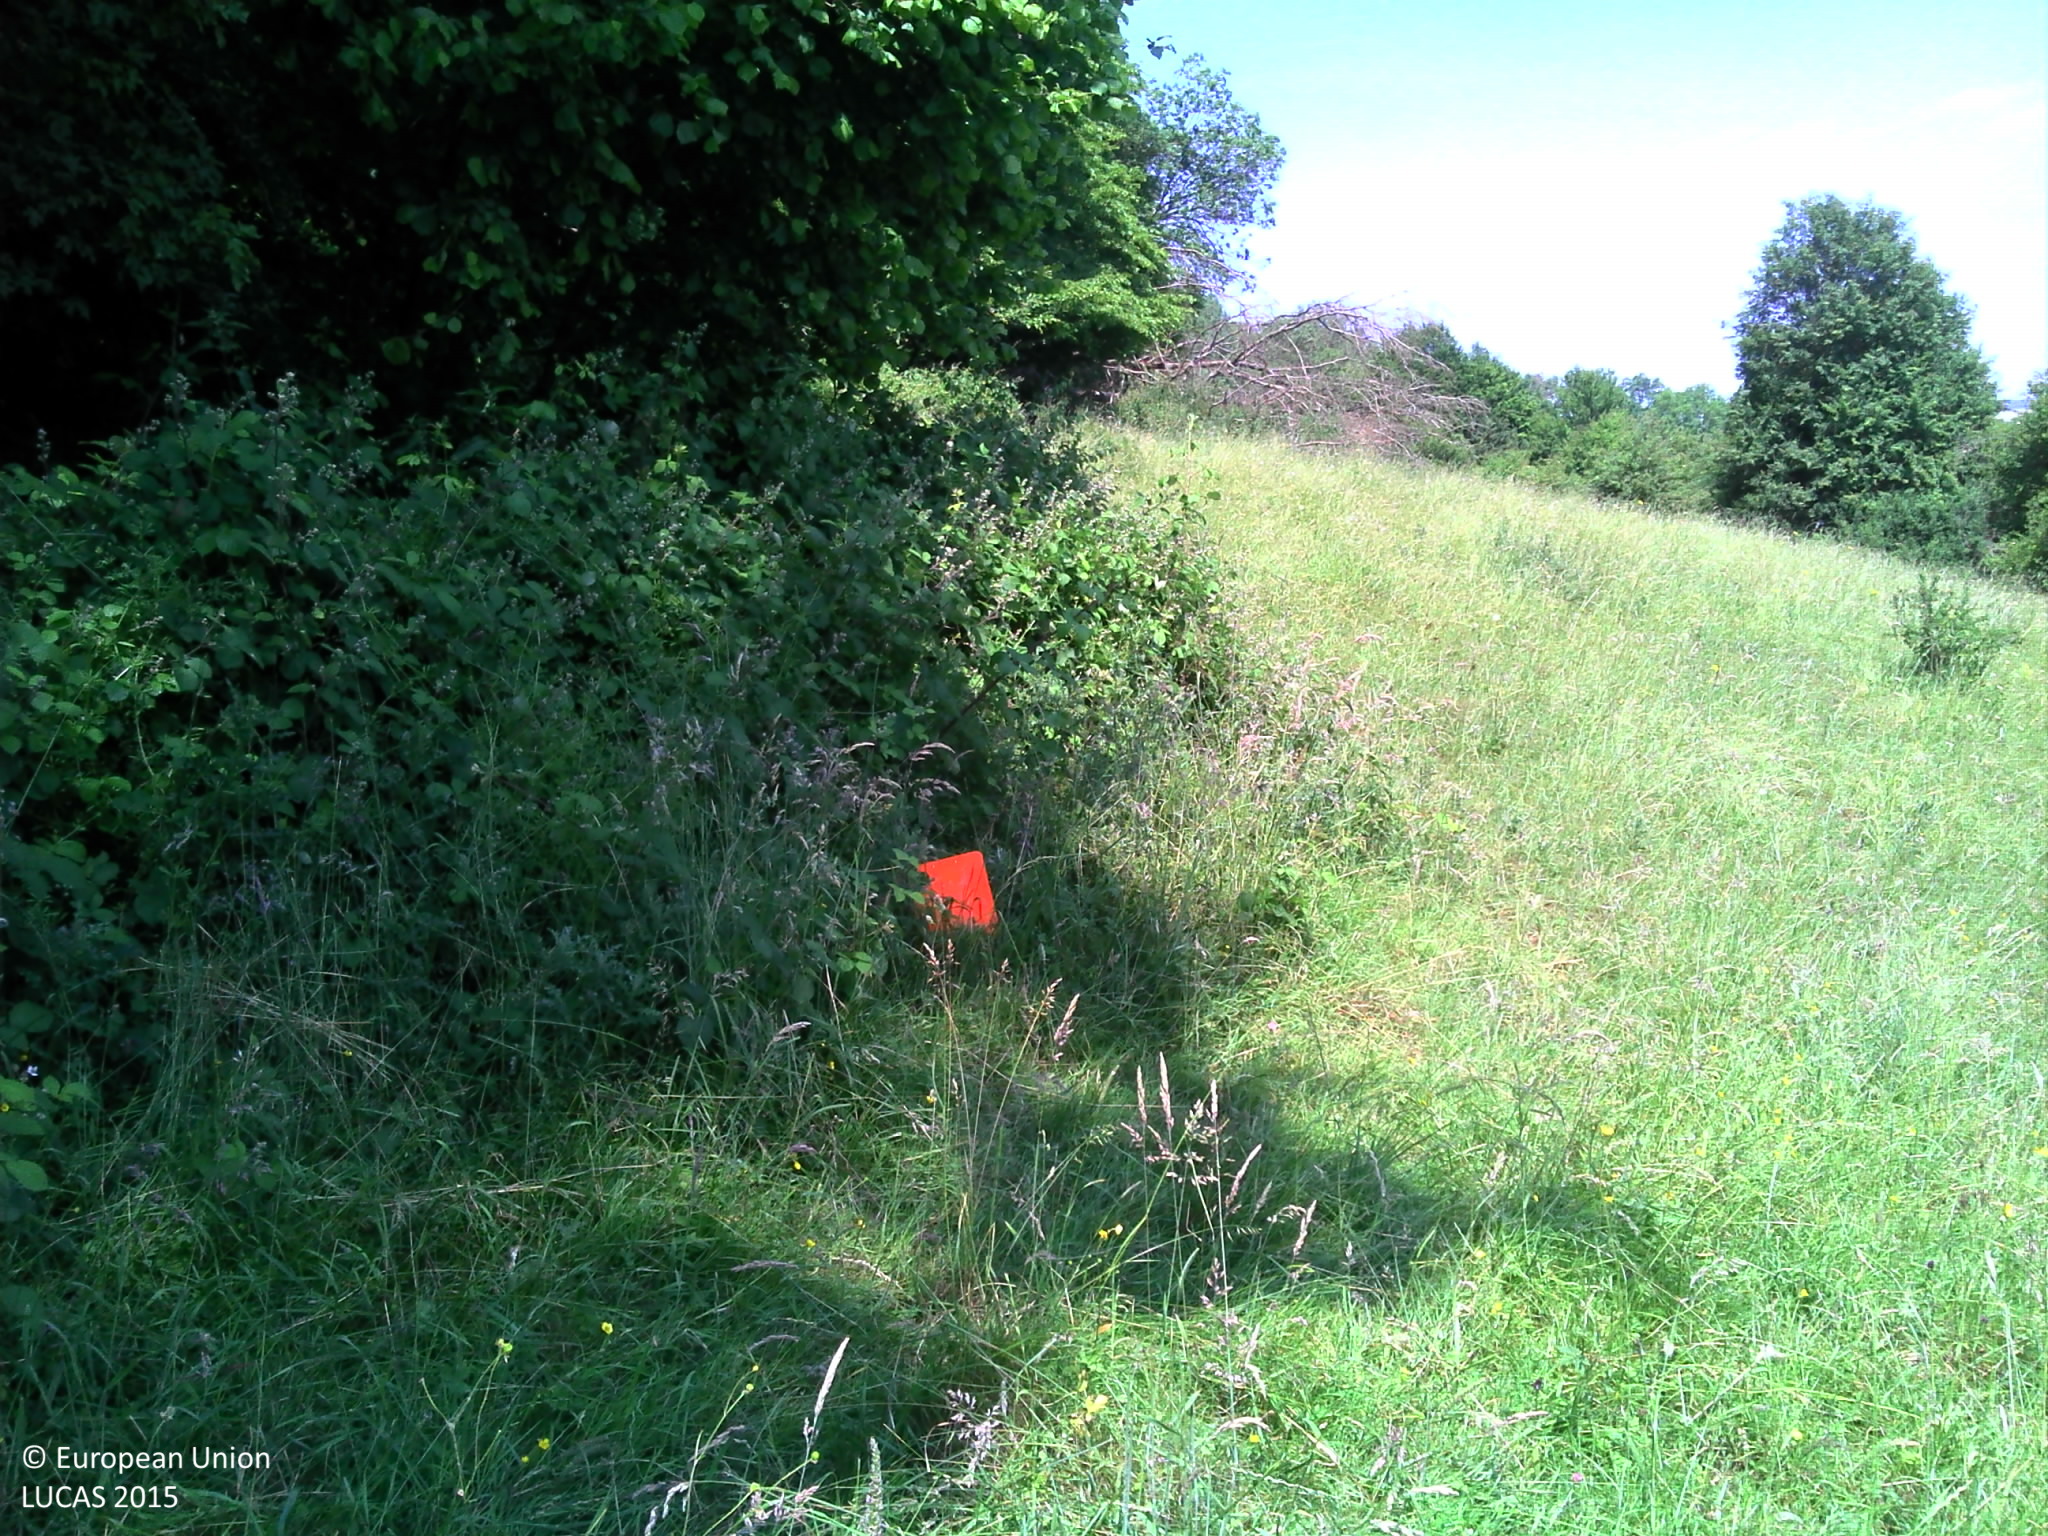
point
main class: Grassland
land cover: Grassland without tree/shrub cover
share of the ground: > 75 %
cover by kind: herbaceous plants 100 %
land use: Agriculture (excluding fallow land and kitchen gardens)
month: June
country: FR
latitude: 48.5030
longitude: 6.2783
